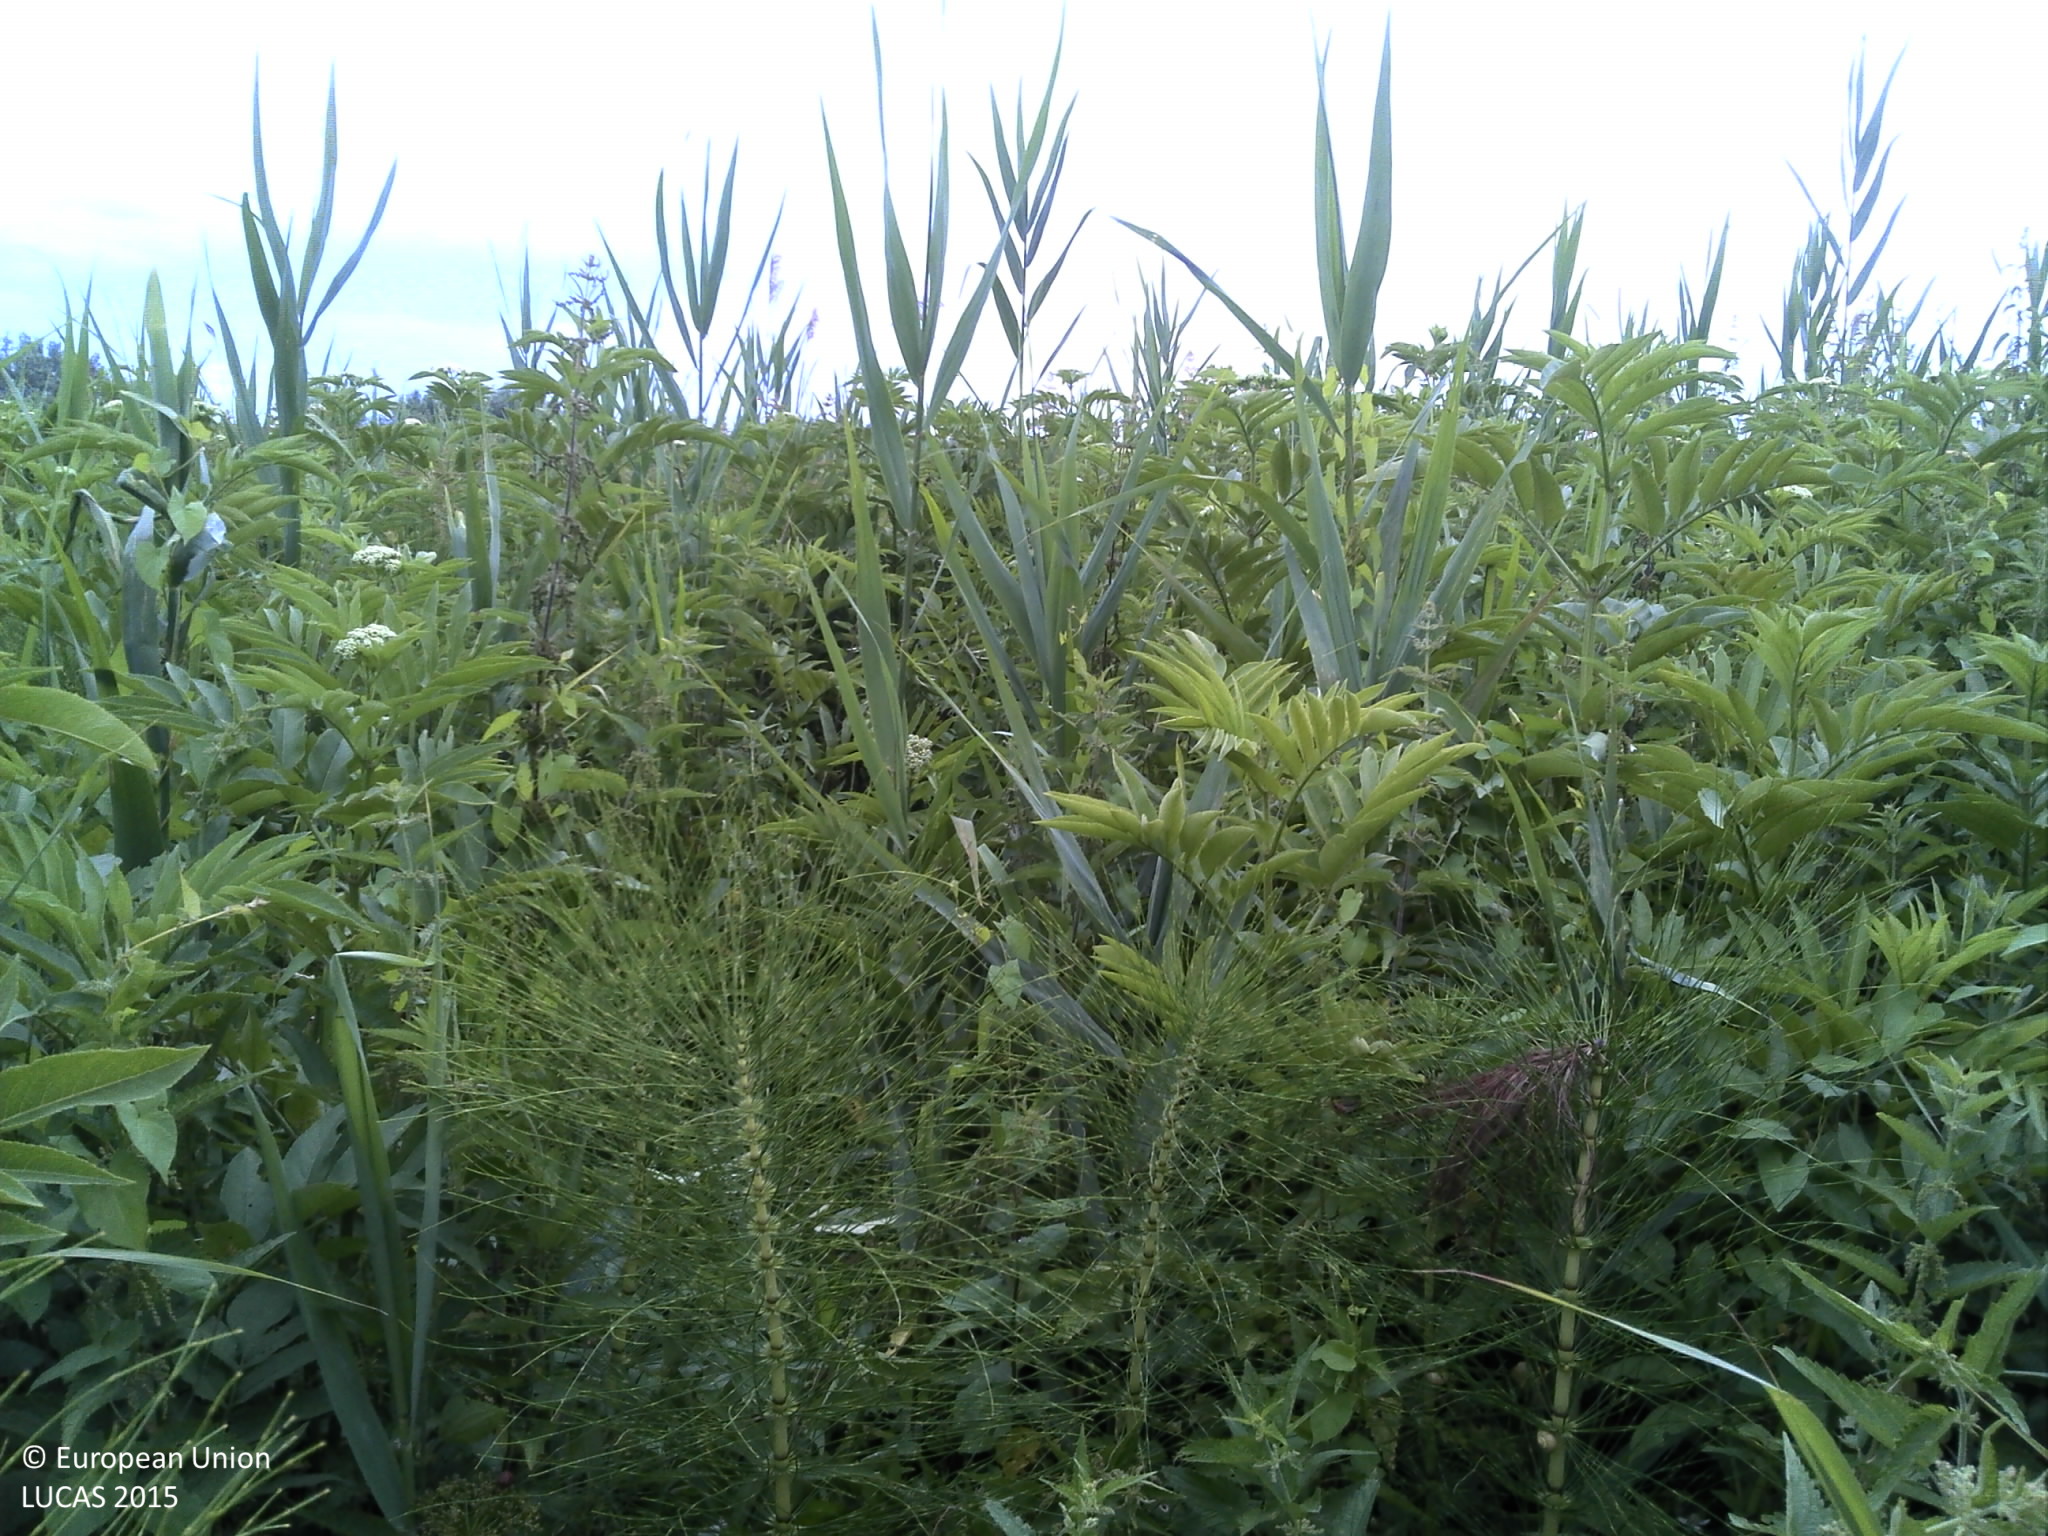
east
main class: Grassland
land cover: Spontaneously vegetated surfaces
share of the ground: > 75 %
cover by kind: herbaceous plants 90 %, shrubs 5 %, lichens and mosses 5 %
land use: Agriculture (excluding fallow land and kitchen gardens)
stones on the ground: < 10 %
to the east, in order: Spontaneously vegetated surfaces; Soya
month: June
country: HR
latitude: 45.2156
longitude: 17.5517
